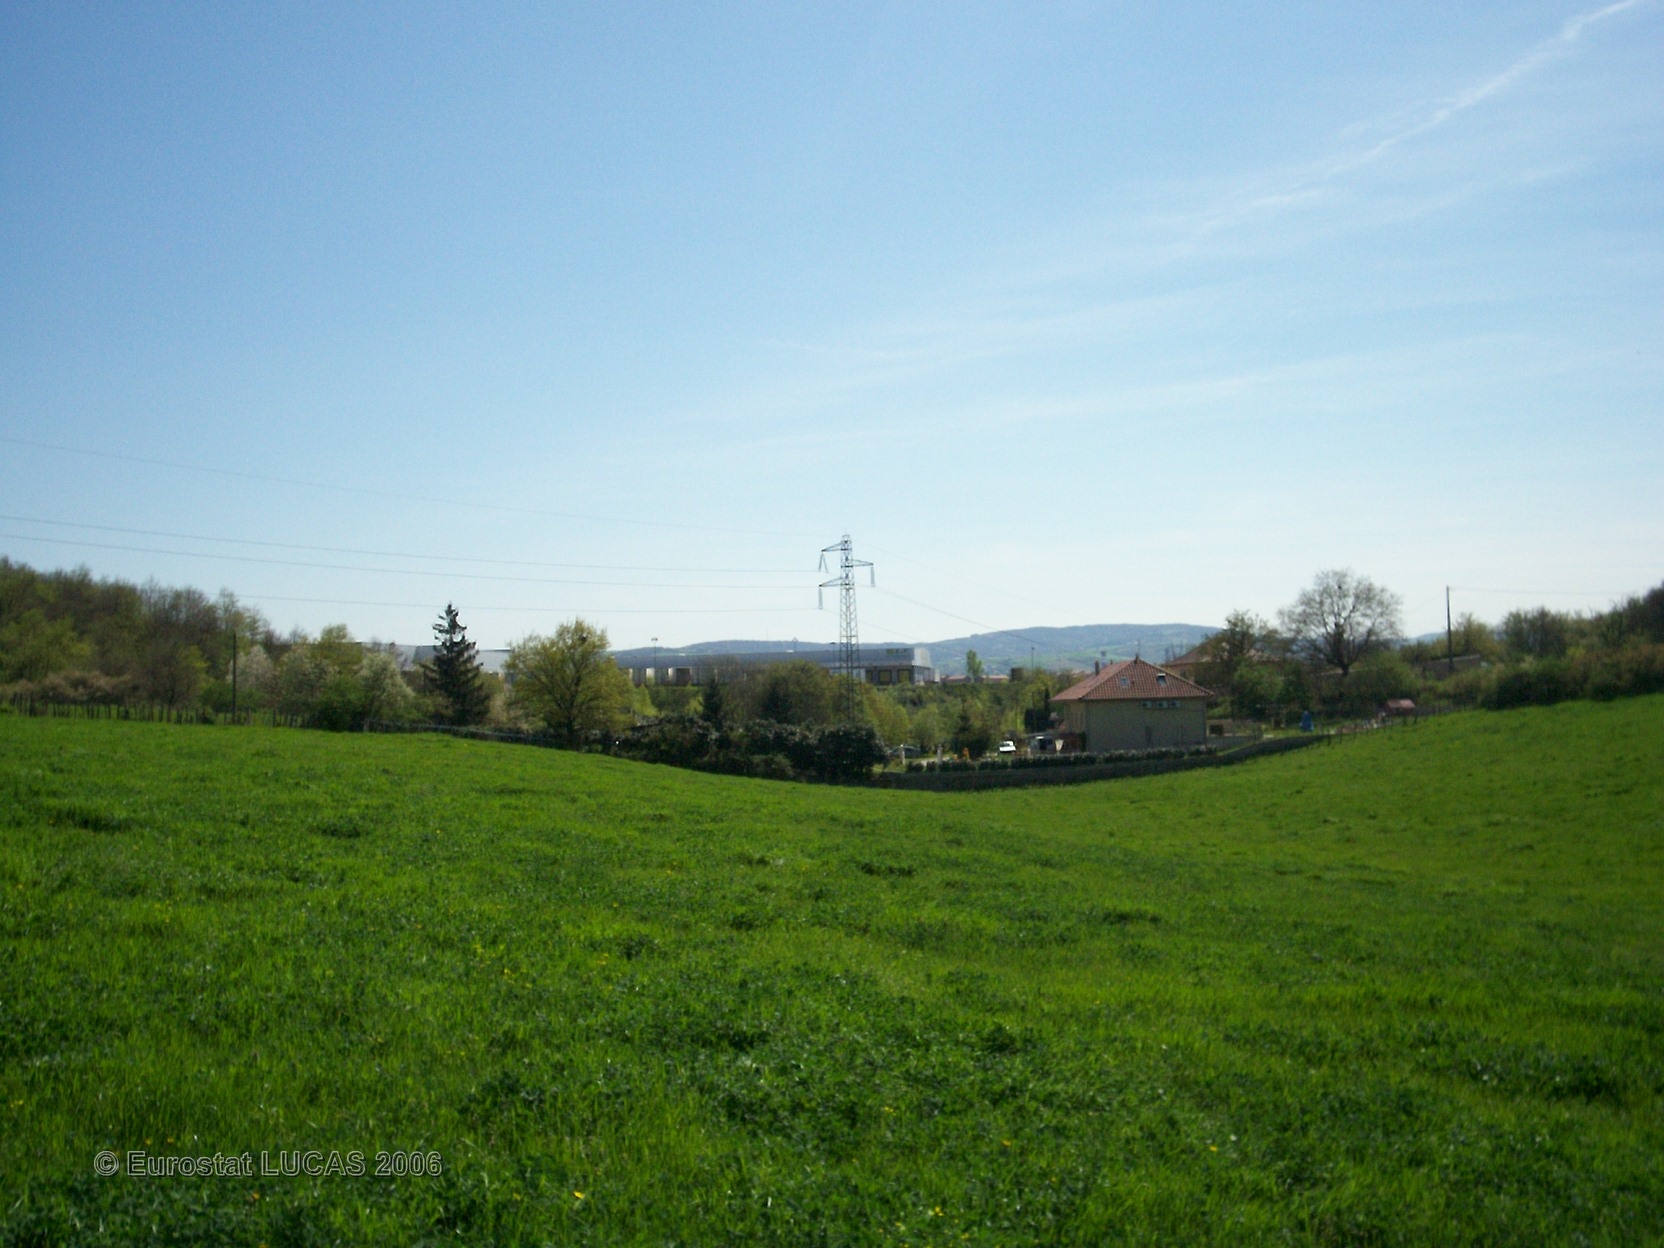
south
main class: Grassland
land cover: Grassland without tree/shrub cover
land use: Agriculture (excluding fallow land and kitchen gardens)
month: April
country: FR
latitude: 45.5936
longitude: 4.8123
